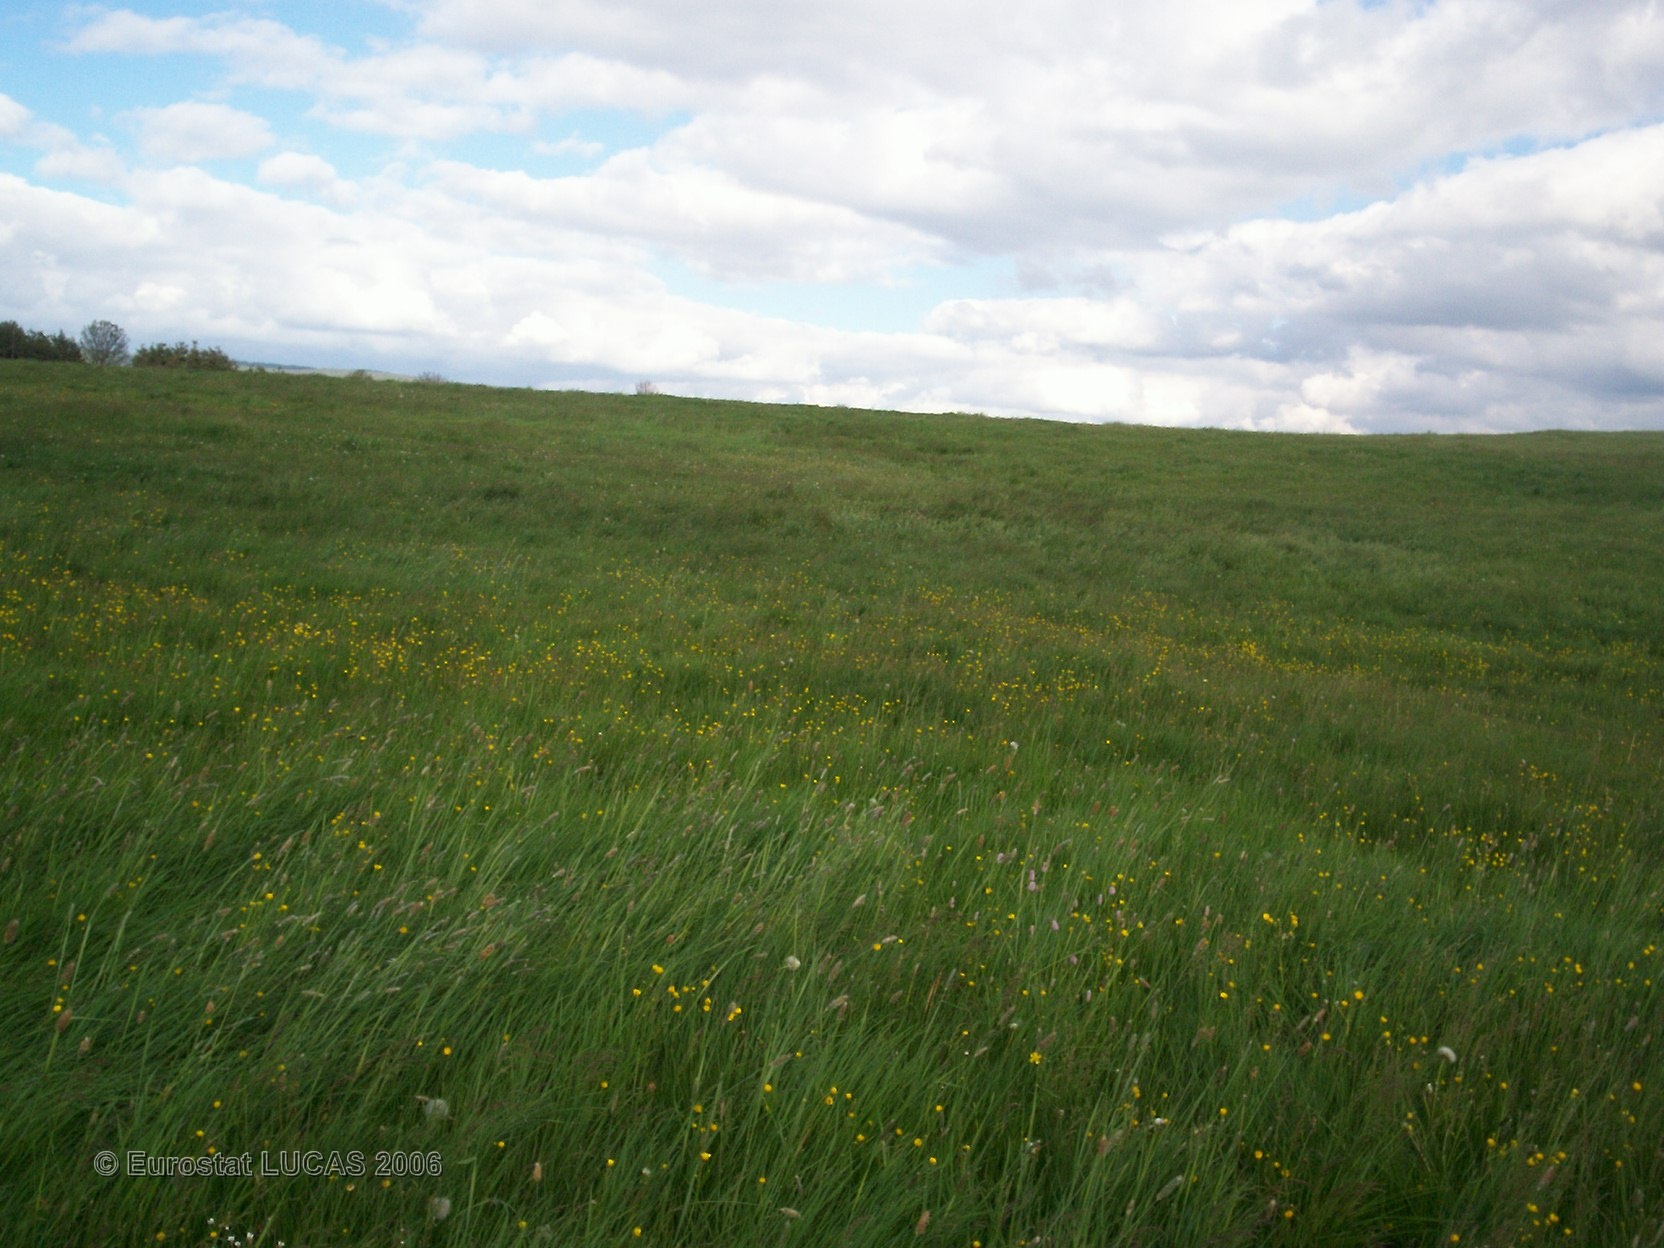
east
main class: Grassland
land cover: Grassland without tree/shrub cover
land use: Agriculture (excluding fallow land and kitchen gardens)
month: May
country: FR
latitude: 44.7013
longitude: 3.4038
